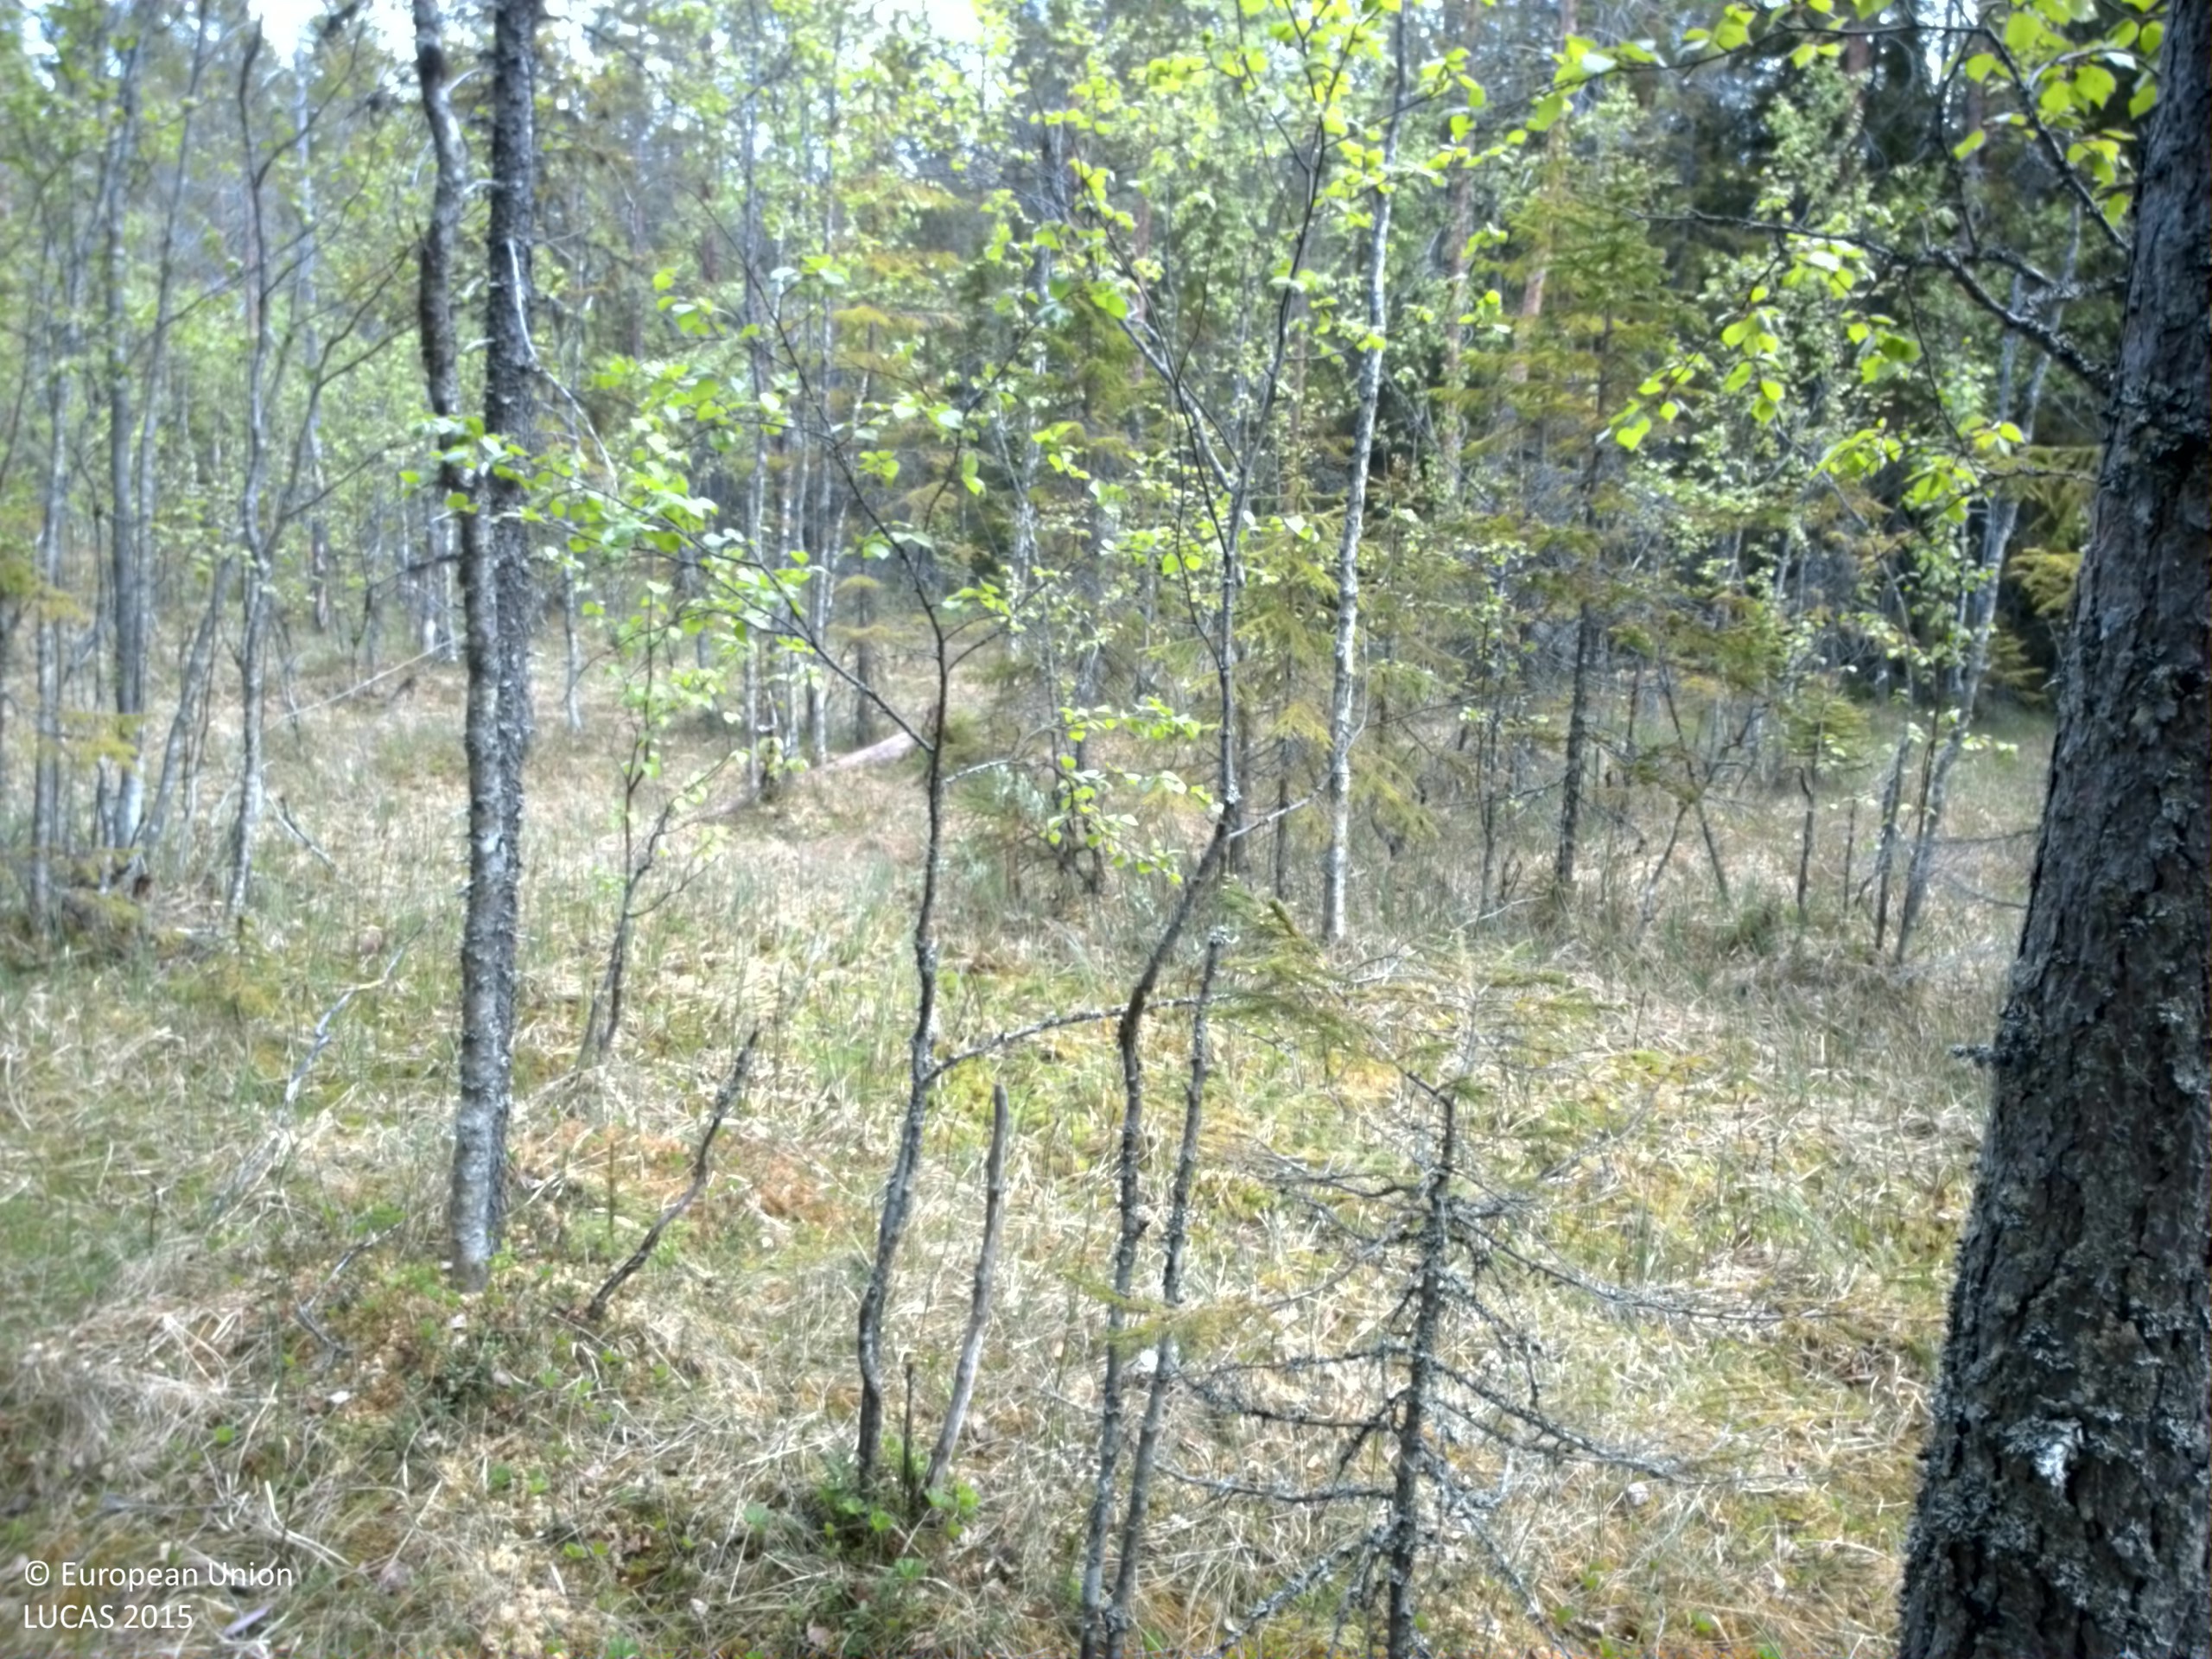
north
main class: Woodland
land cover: Other mixed woodland
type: boreal forest
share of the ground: > 75 %
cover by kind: coniferous forest trees 50 %, broadleaved forest trees 30 %, herbaceous plants 20 %
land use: Forestry
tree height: > 5 m
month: June
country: SE
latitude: 63.0365
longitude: 17.2316
